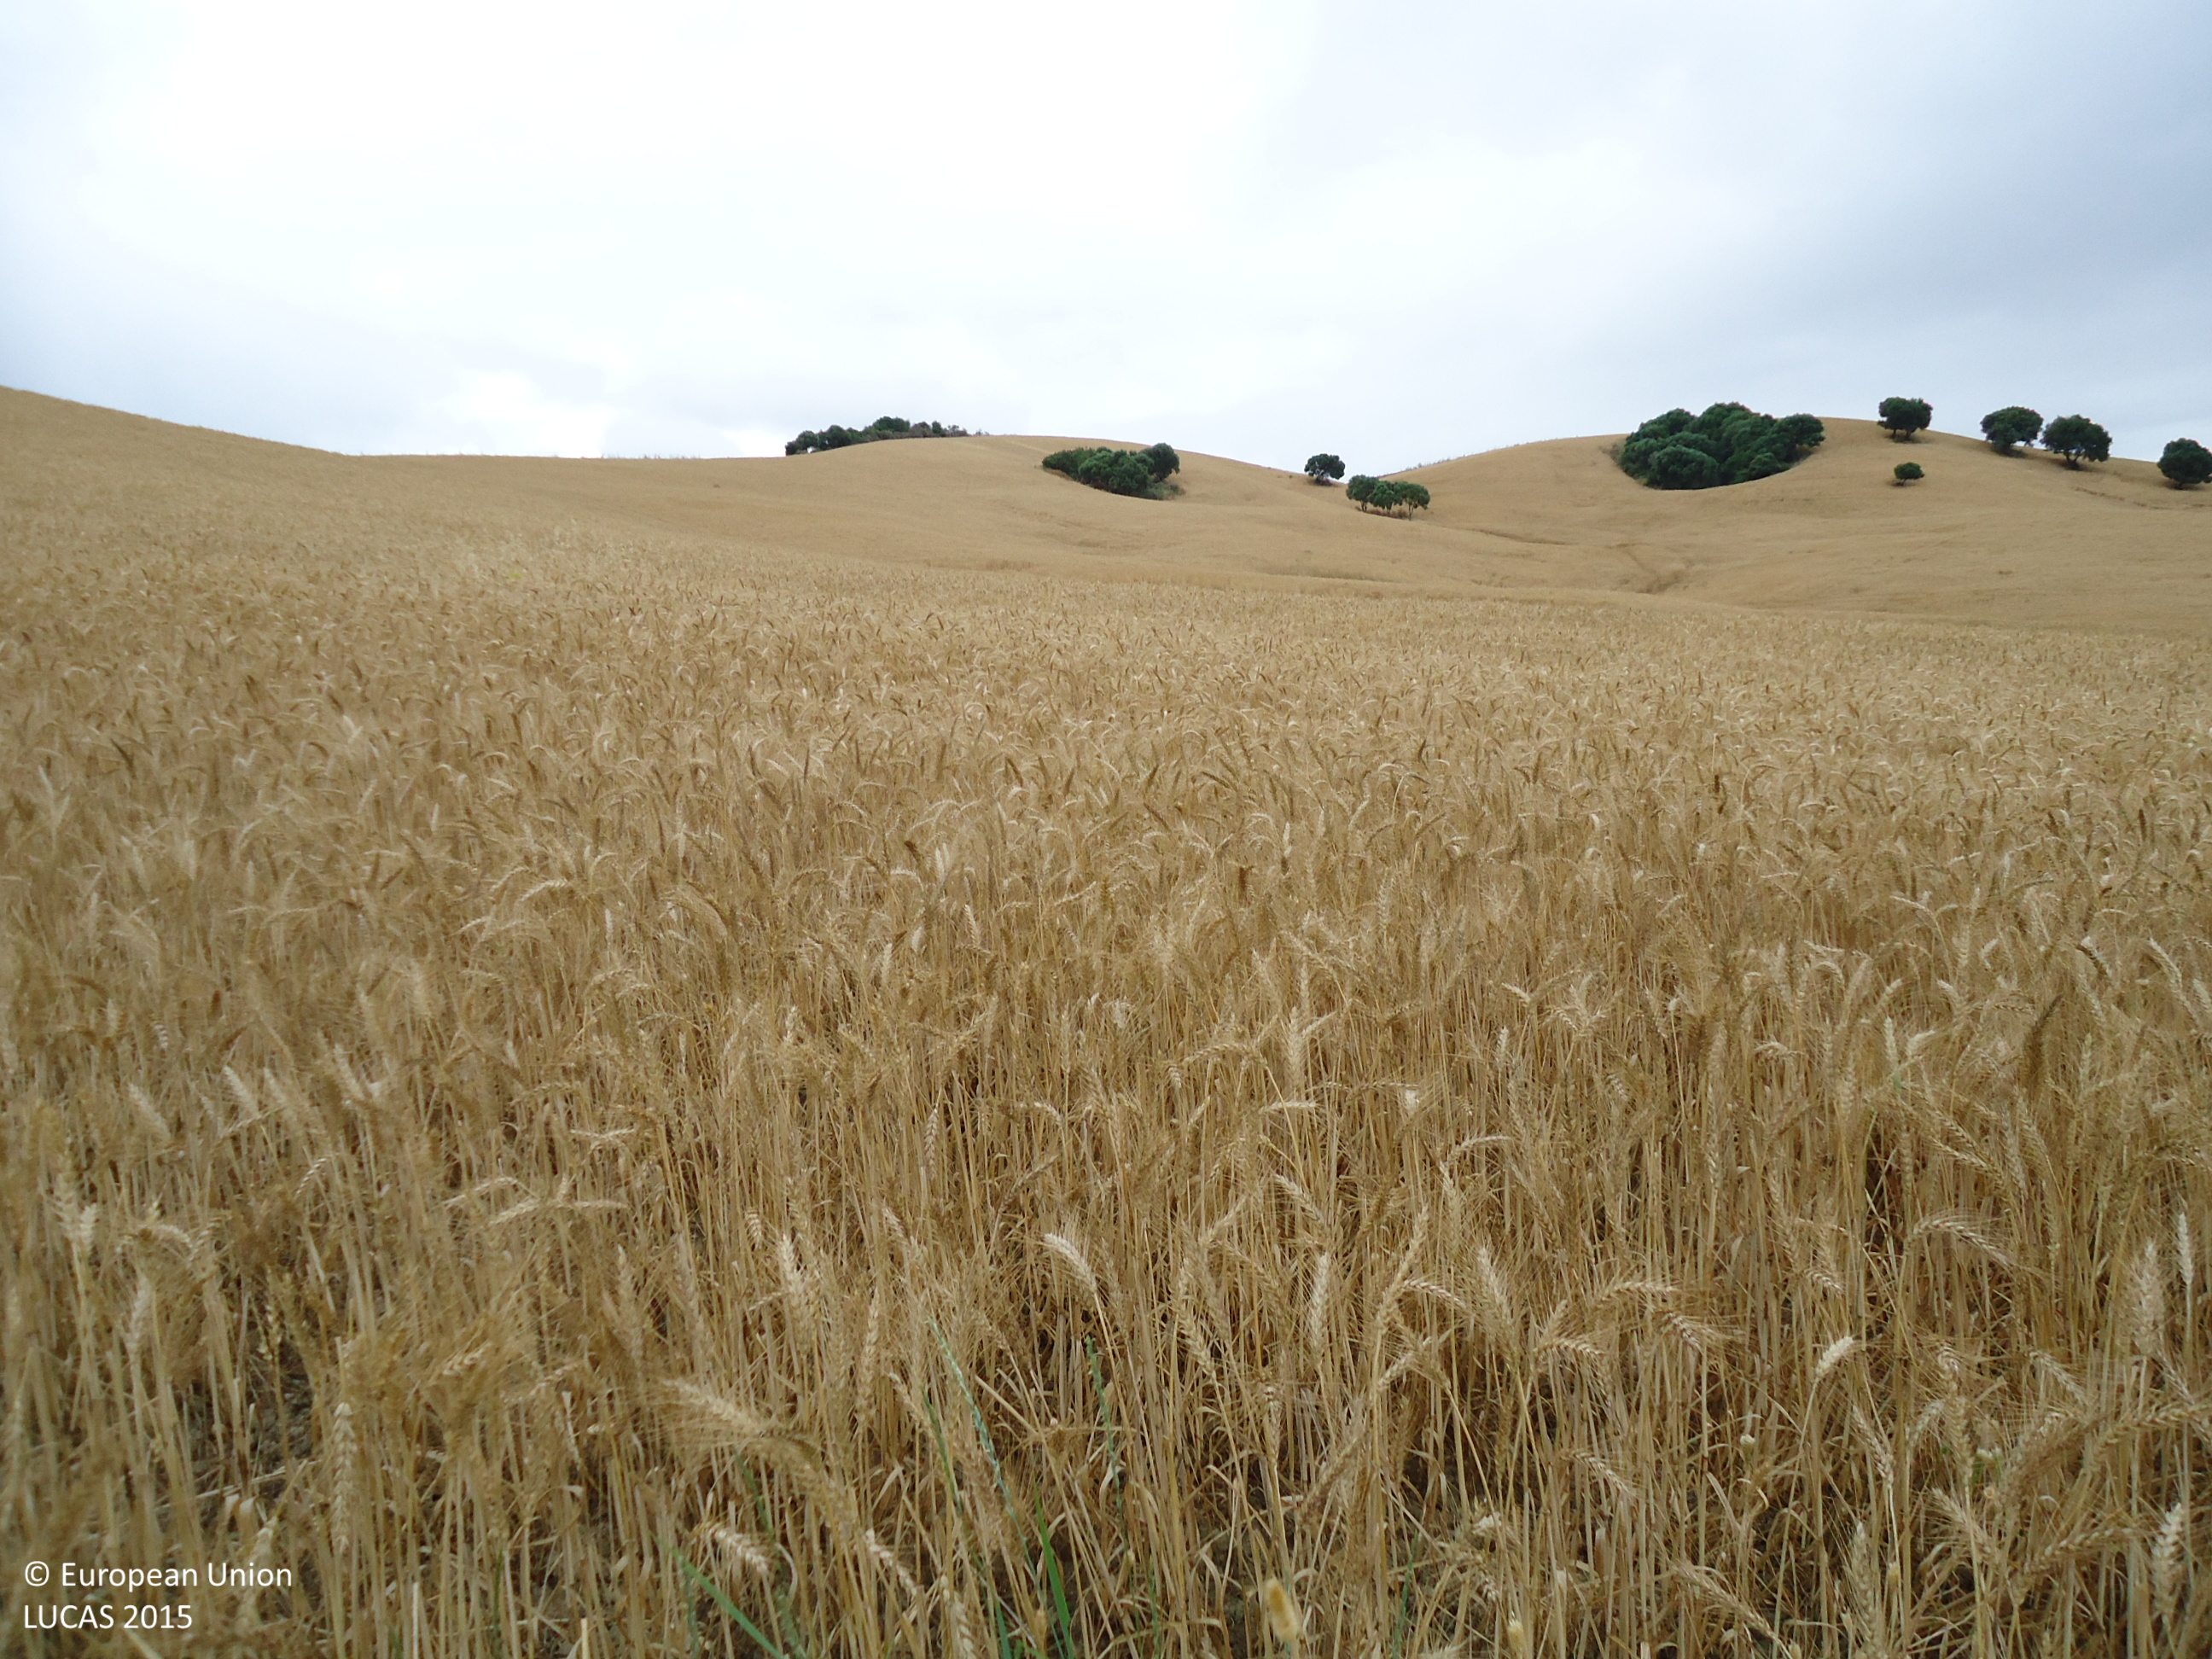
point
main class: Cropland
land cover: Barley
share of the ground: > 75 %
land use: Agriculture (excluding fallow land and kitchen gardens)
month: June
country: ES
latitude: 36.4154
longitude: -5.3747
